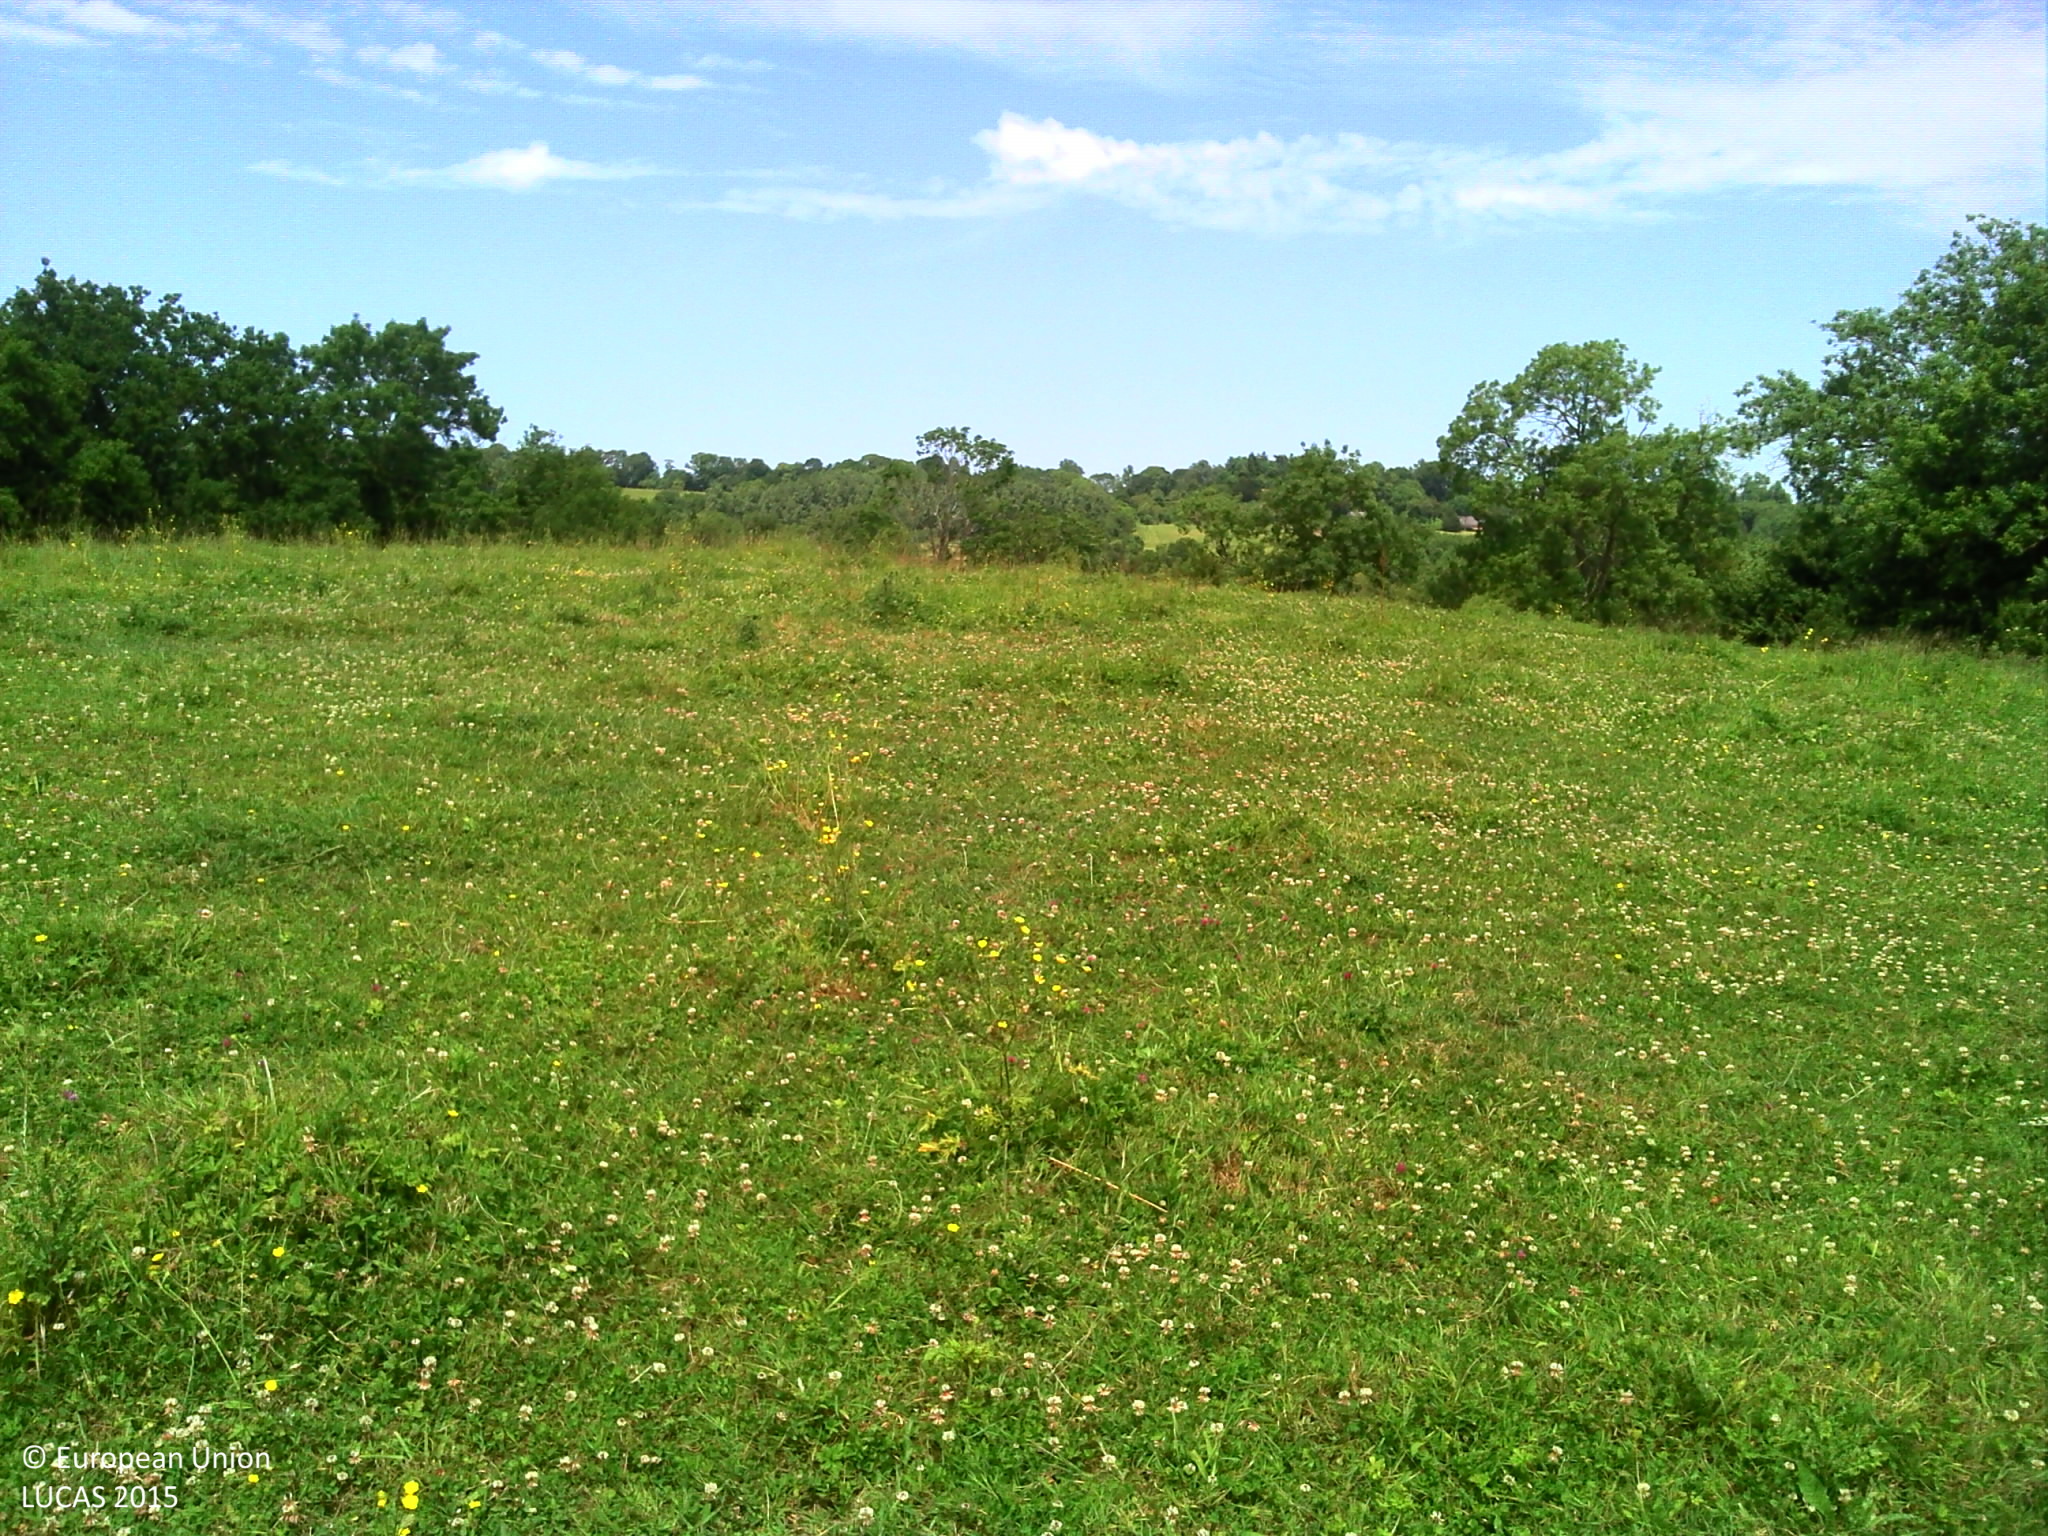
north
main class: Grassland
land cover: Grassland without tree/shrub cover
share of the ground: > 75 %
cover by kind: herbaceous plants 100 %
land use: Agriculture (excluding fallow land and kitchen gardens)
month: June
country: FR
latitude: 49.1966
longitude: -0.0356
